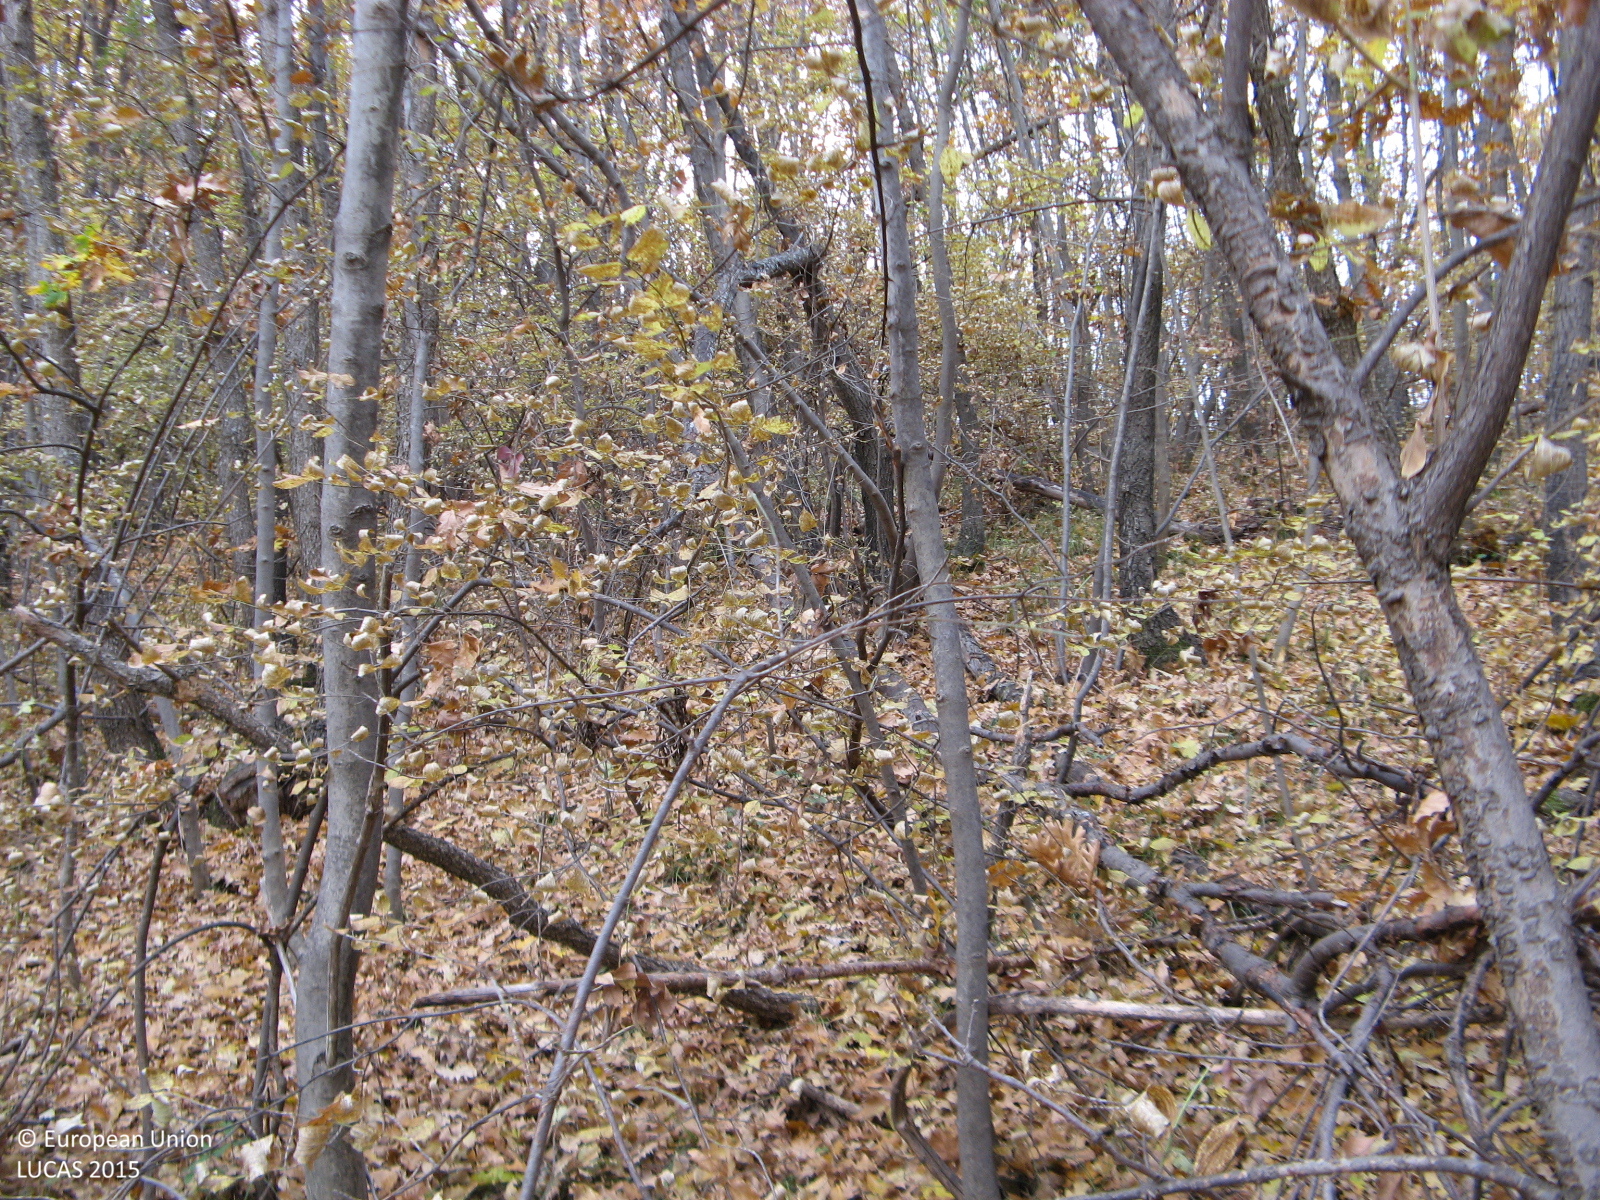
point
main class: Woodland
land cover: Broadleaved woodland
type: mesophytic deciduous forest
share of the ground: > 75 %
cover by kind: broadleaved forest trees 95 %, unconsolidated bare surface 5 %
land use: Forestry
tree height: > 5 m
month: November
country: BG
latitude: 41.7258
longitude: 25.9745
